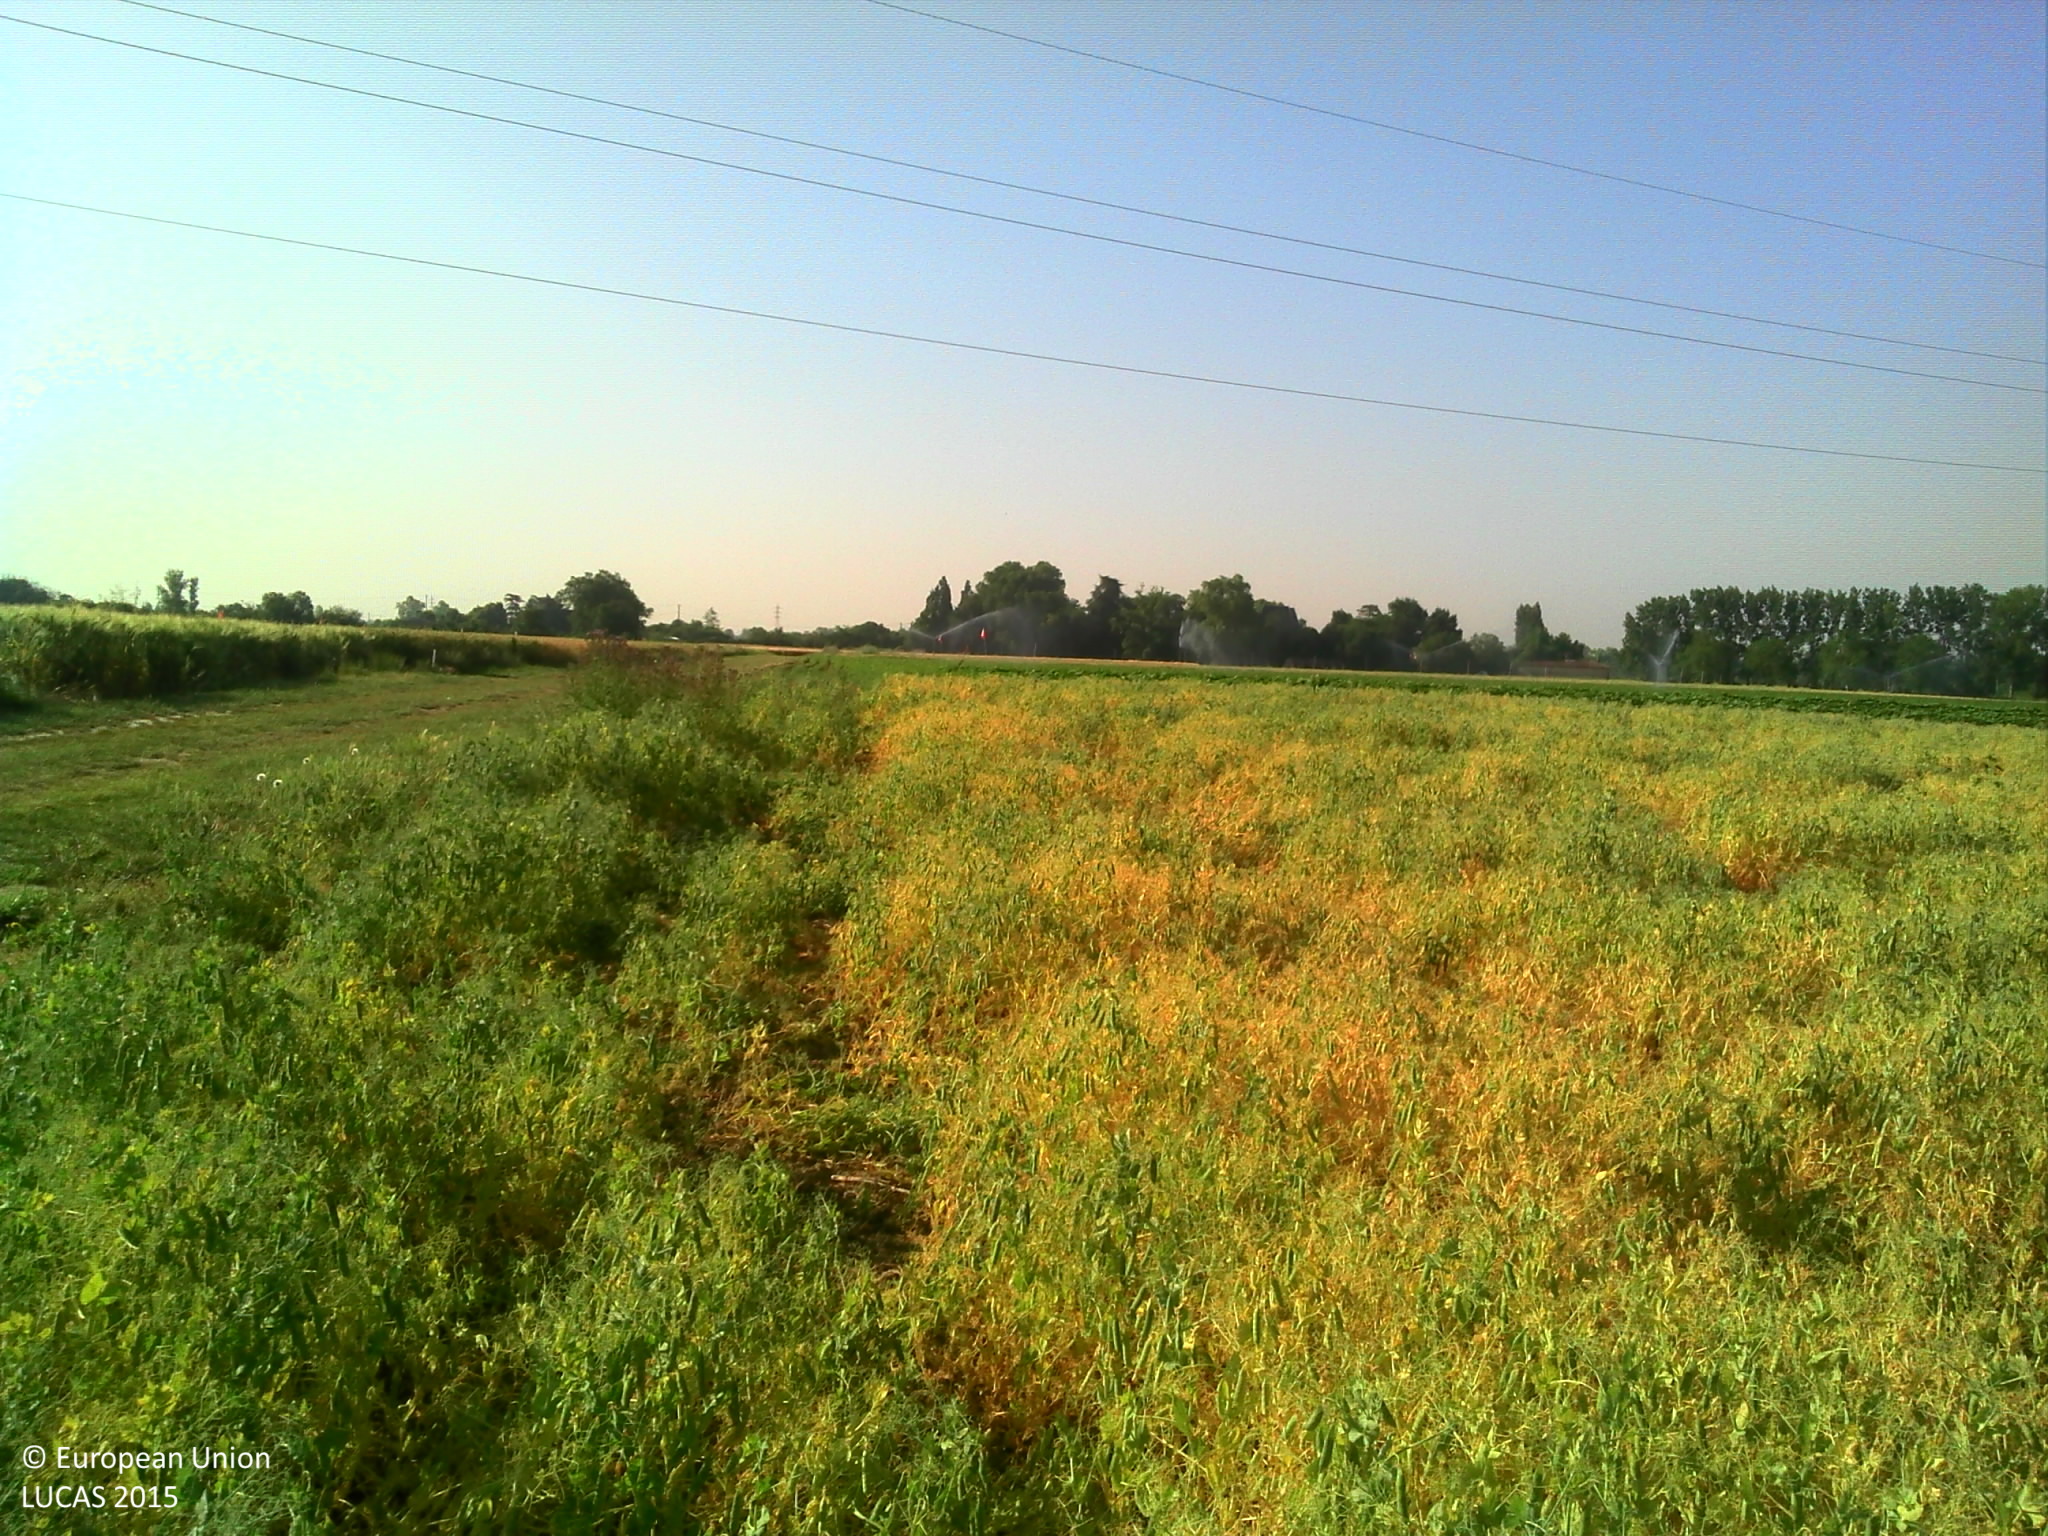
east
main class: Cropland
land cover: Dry pulses
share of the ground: > 75 %
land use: Agriculture (excluding fallow land and kitchen gardens)
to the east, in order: Dry pulses; Tracks; Durum wheat; Electric lines; Common wheat
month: June
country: FR
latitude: 43.8022
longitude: 1.2876
